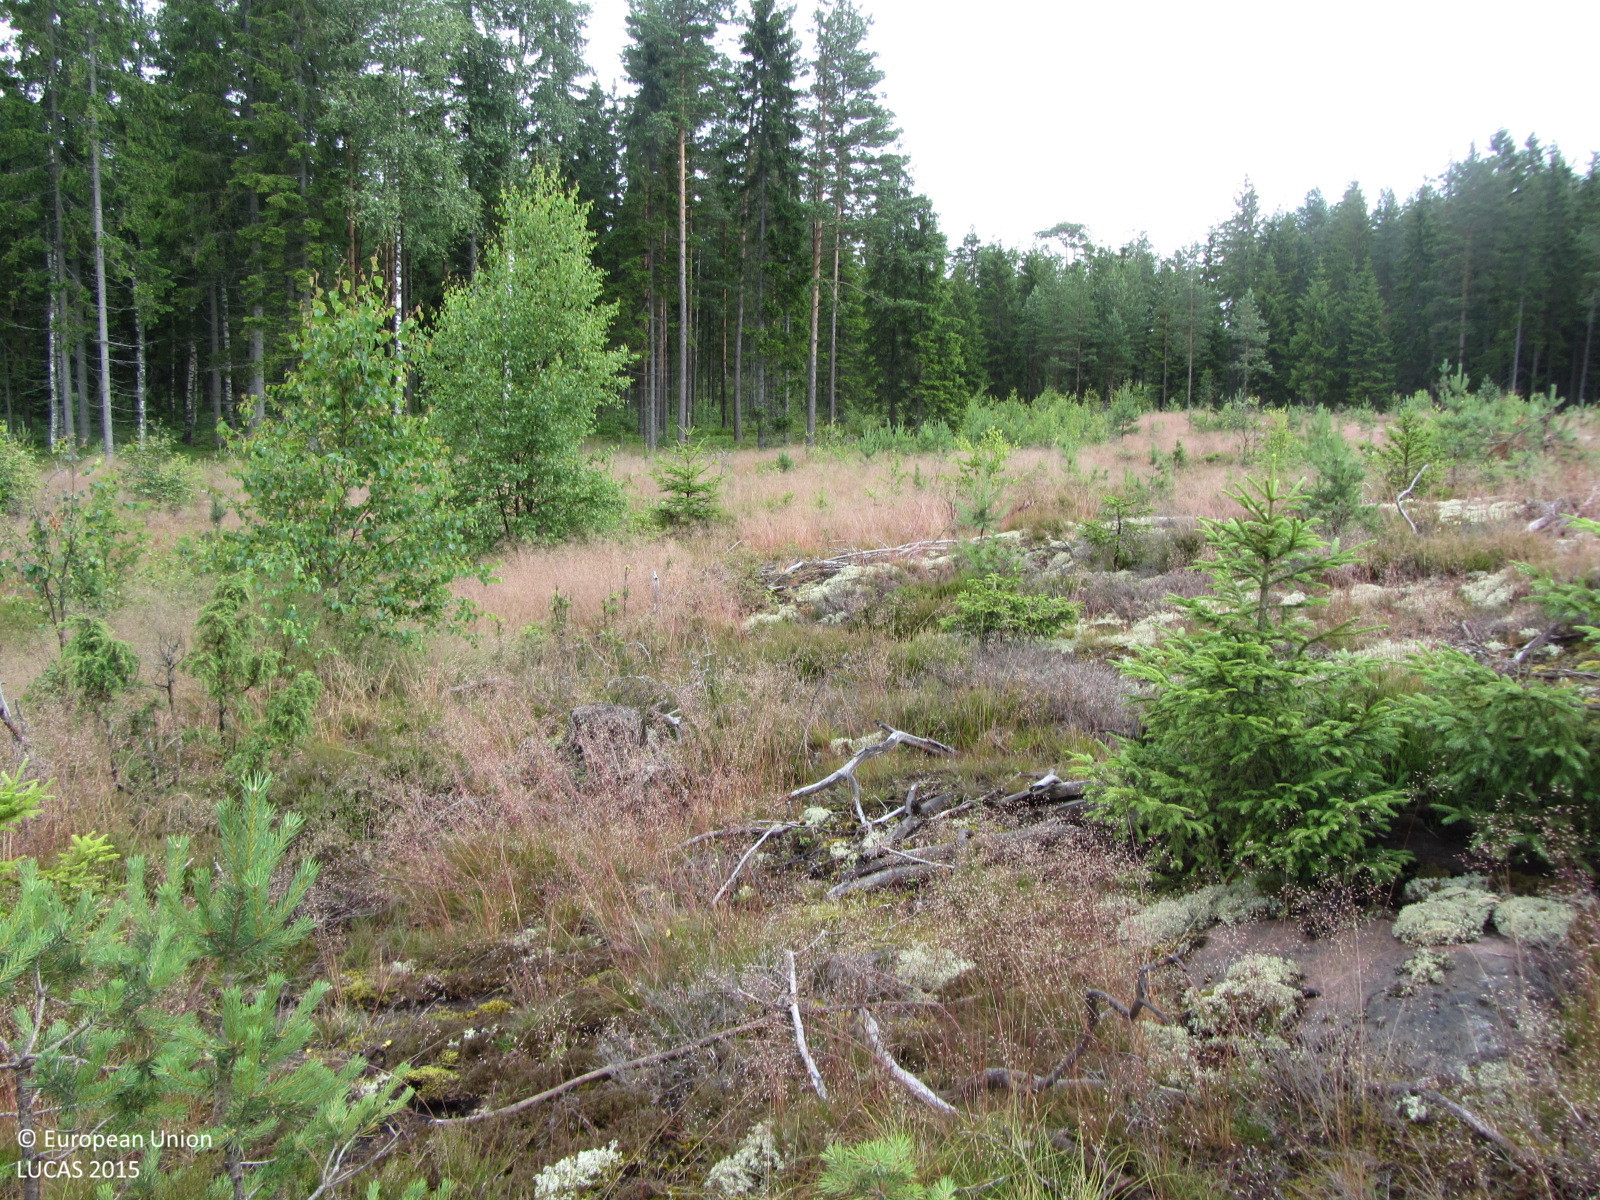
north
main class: Woodland
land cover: Other mixed woodland
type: boreal forest
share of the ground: 10 - 25 %
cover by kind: lichens and mosses 40 %, shrubs 20 %, herbaceous plants 20 %, coniferous forest trees 15 %, broadleaved forest trees 5 %
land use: Forestry
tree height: < 5 m
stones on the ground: 10 - 25 %
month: July
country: FI
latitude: 60.0935
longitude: 24.0715
